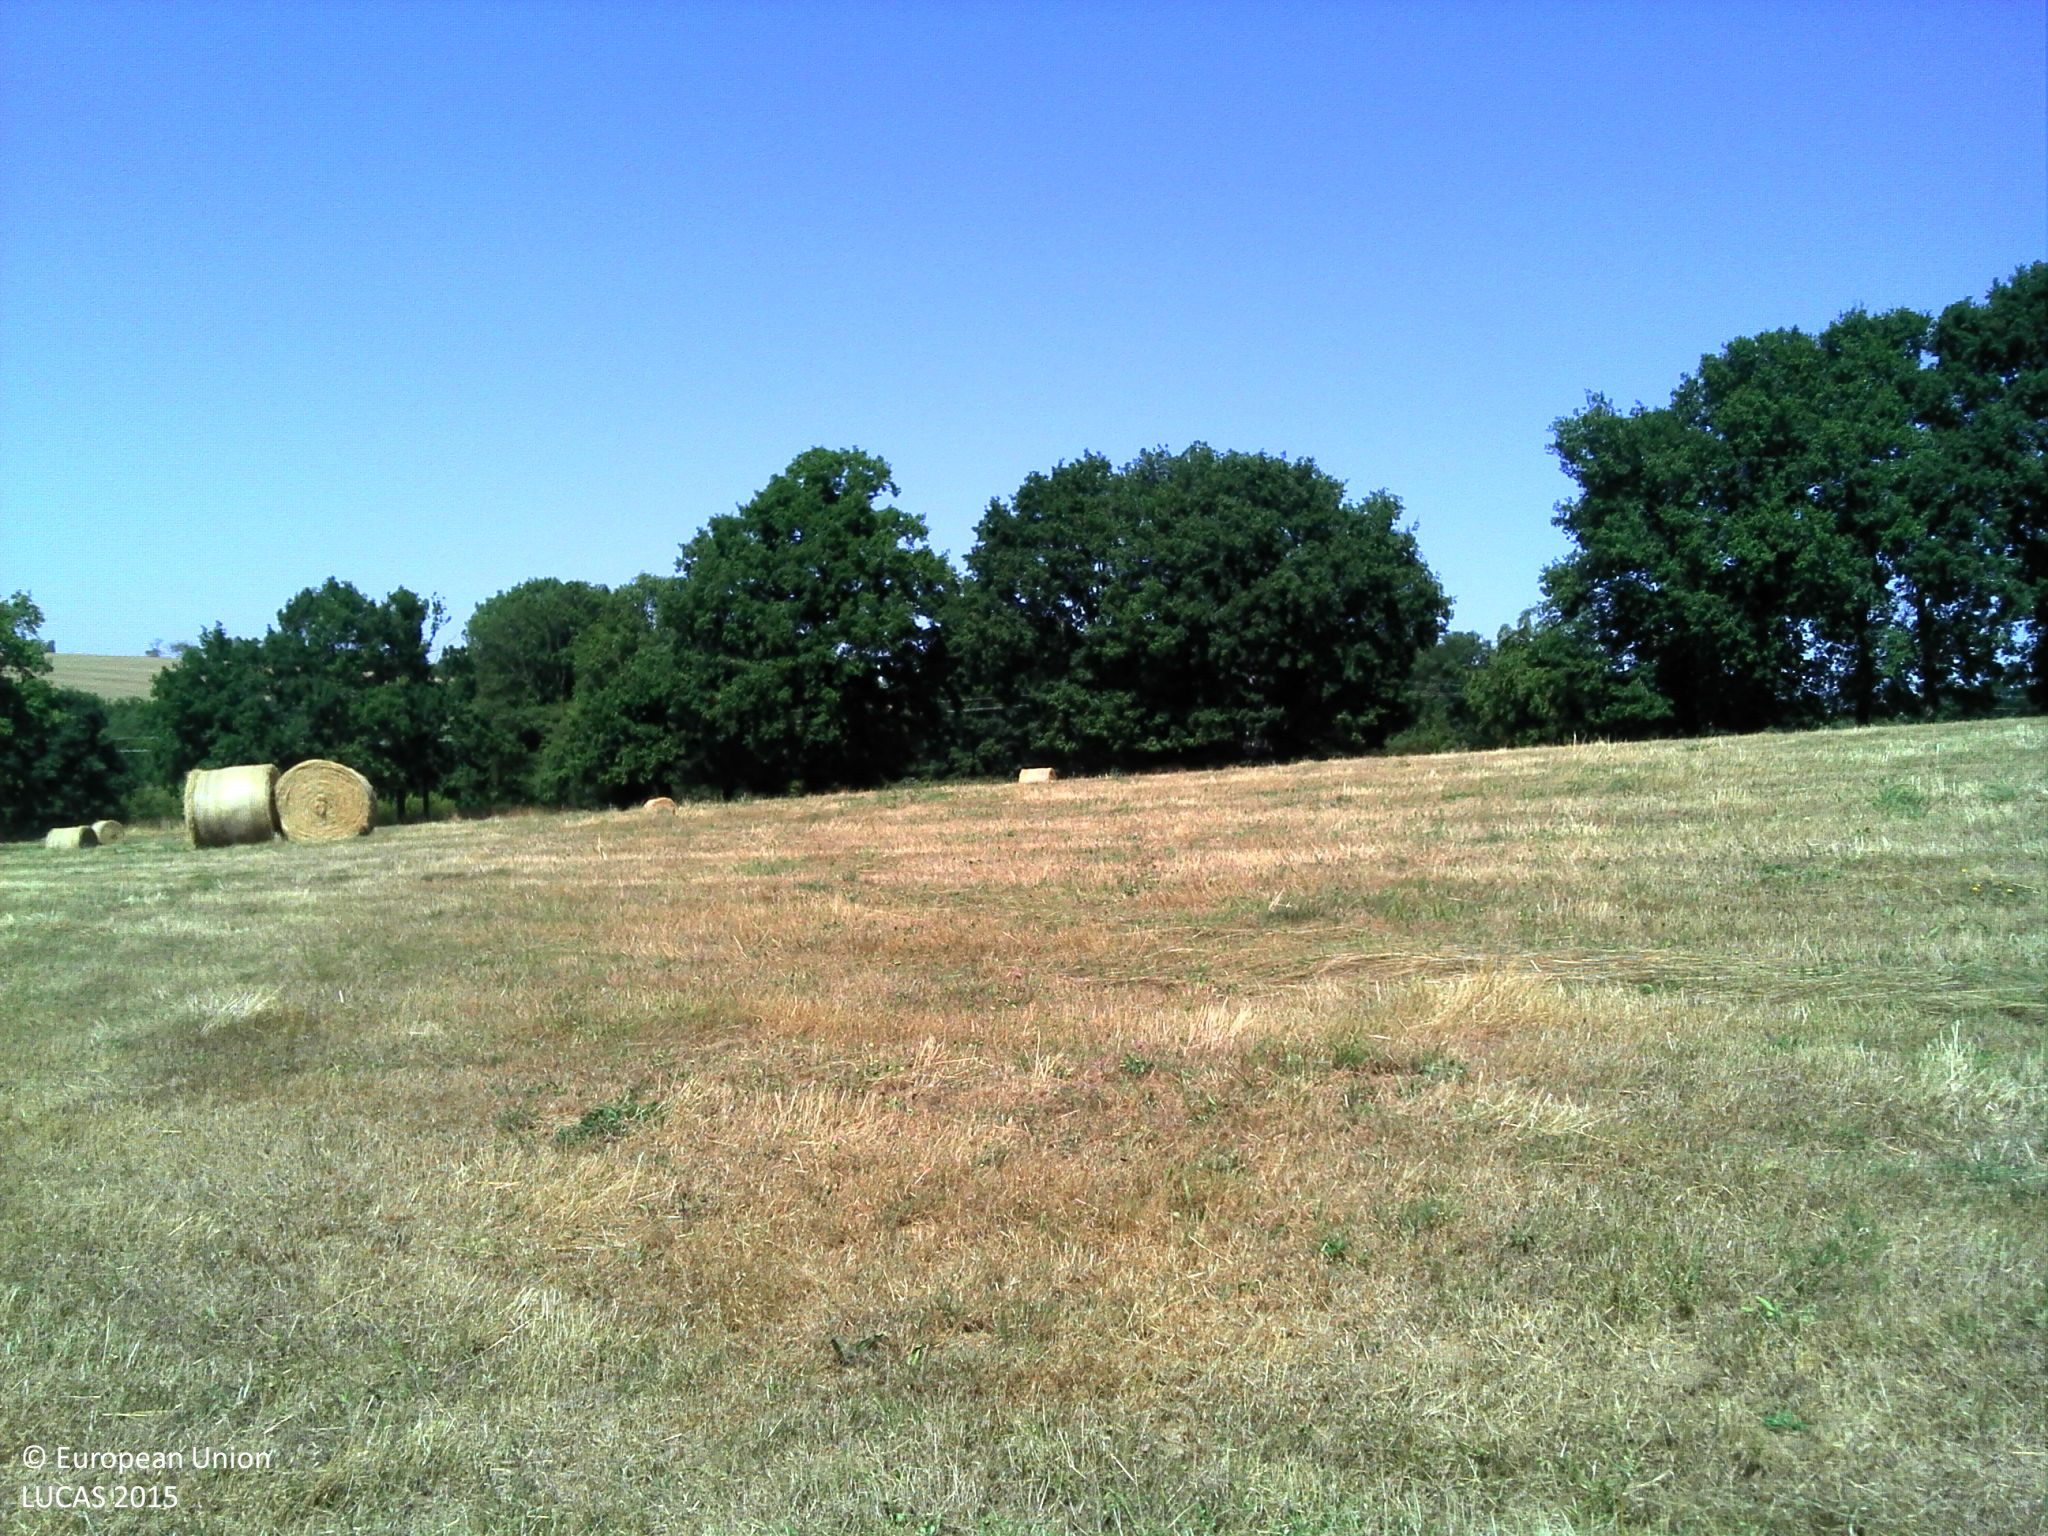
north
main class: Grassland
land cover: Grassland without tree/shrub cover
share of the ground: > 75 %
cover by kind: herbaceous plants 100 %
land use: Agriculture (excluding fallow land and kitchen gardens)
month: August
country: FR
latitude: 46.1441
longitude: 3.6438
